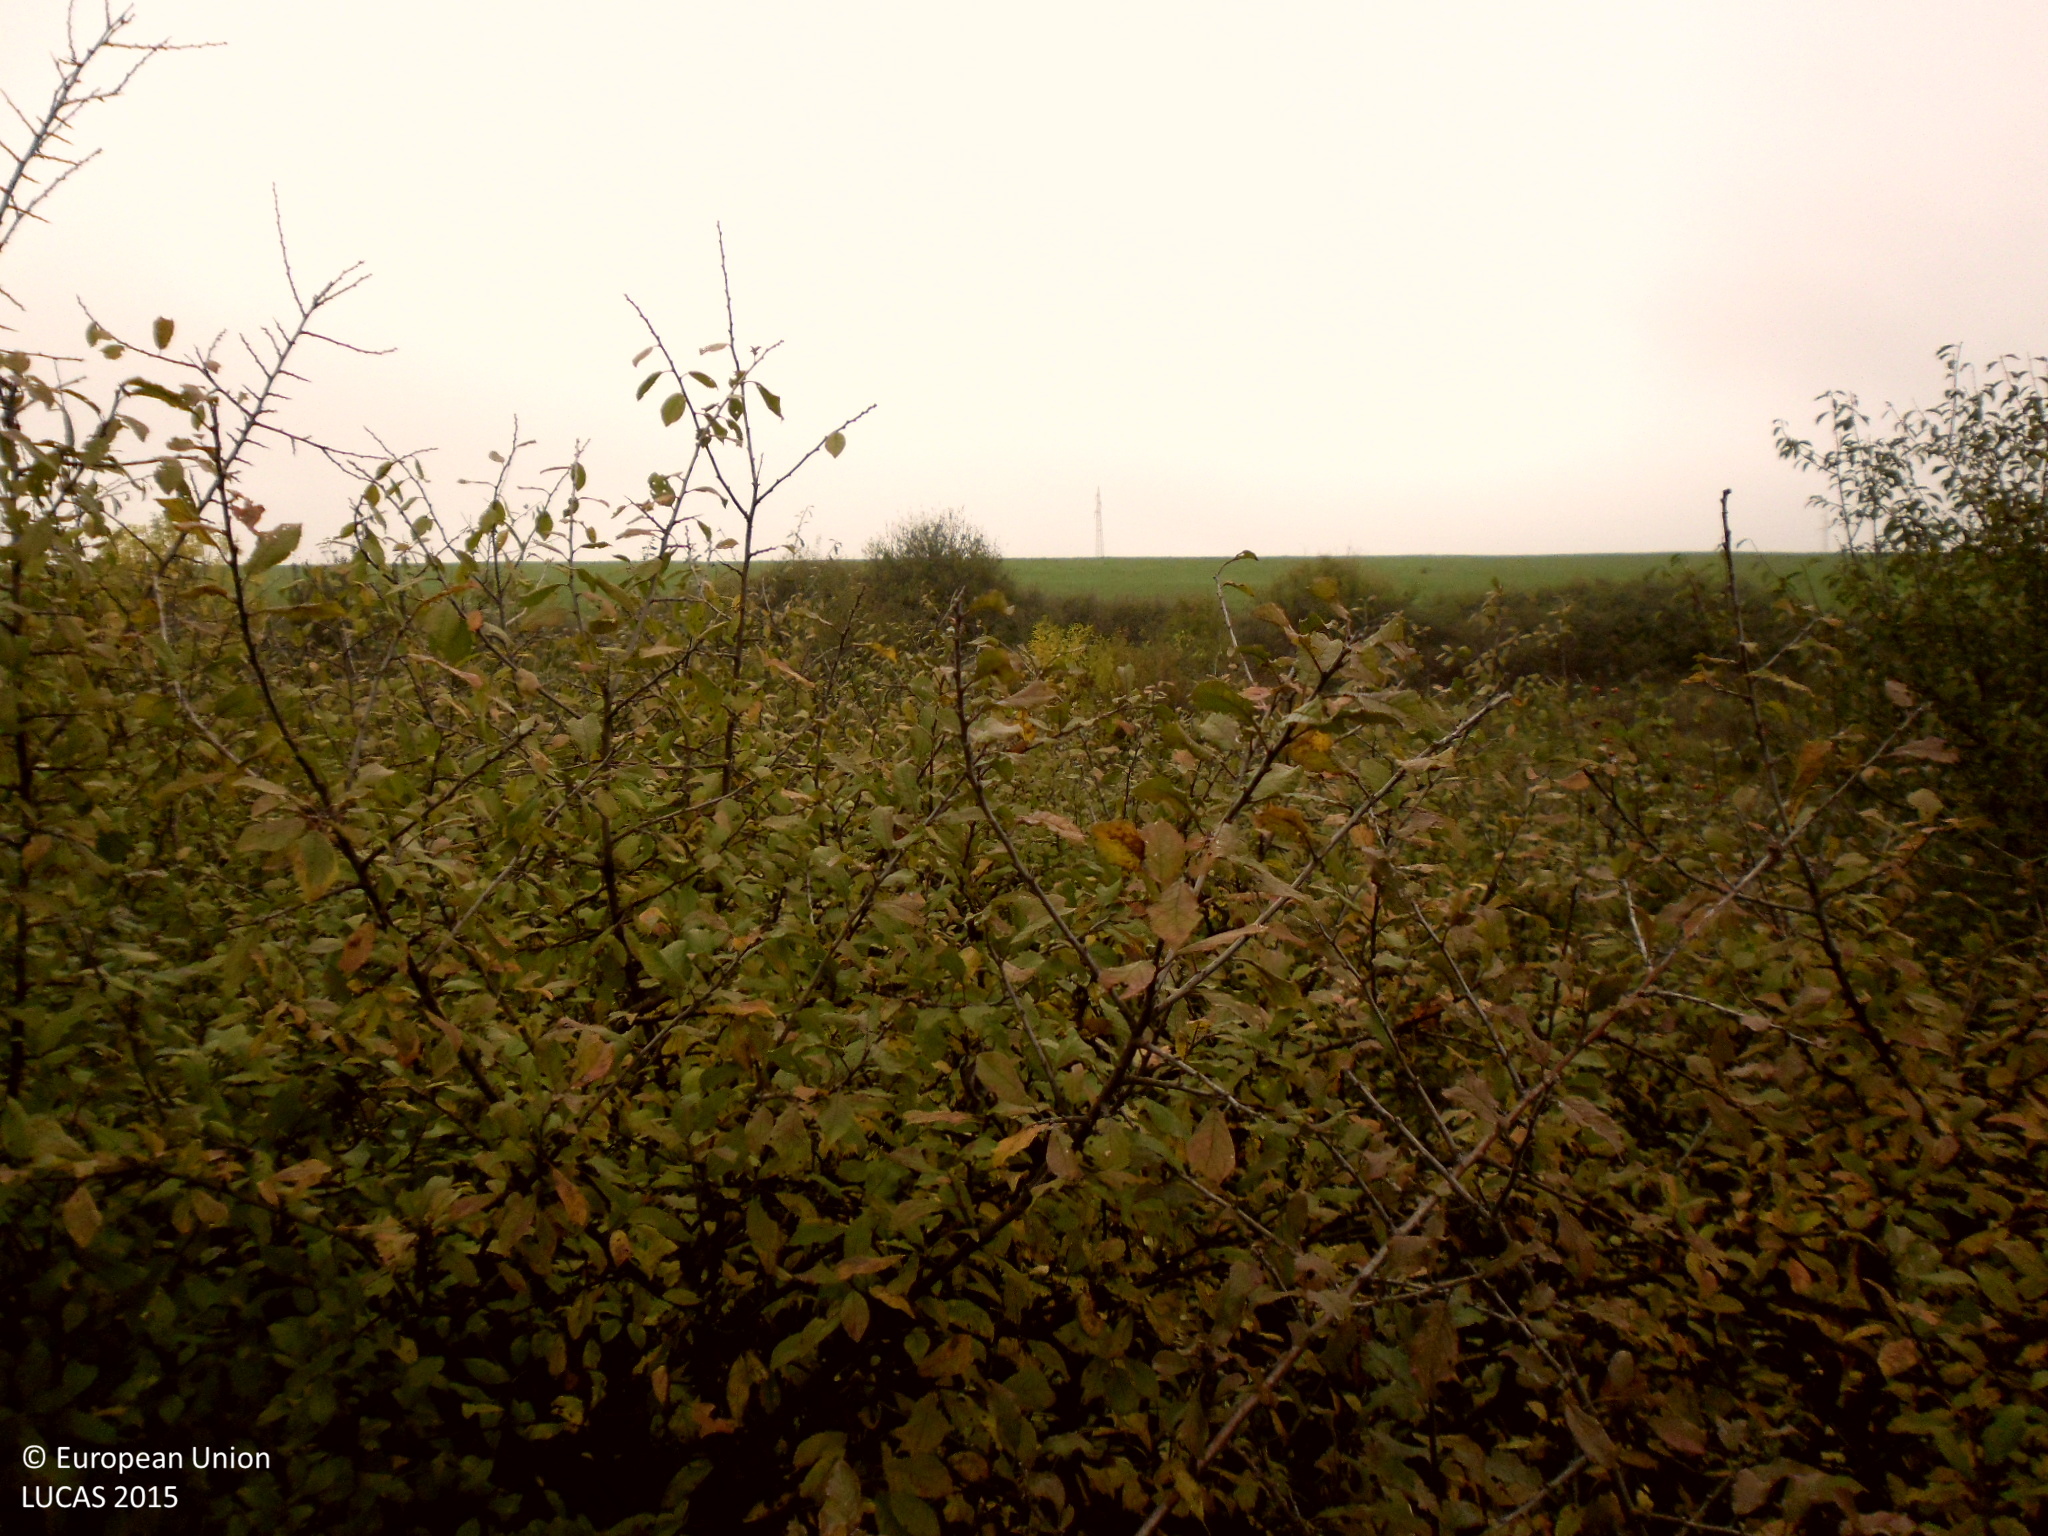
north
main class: Shrubland
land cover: Shrubland with sparse tree cover
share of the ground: > 75 %
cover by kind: shrubs 95 %, broadleaved forest trees 5 %
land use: Semi-natural and natural areas not in use
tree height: < 5 m
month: October
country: BG
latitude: 43.9223
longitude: 22.6272
